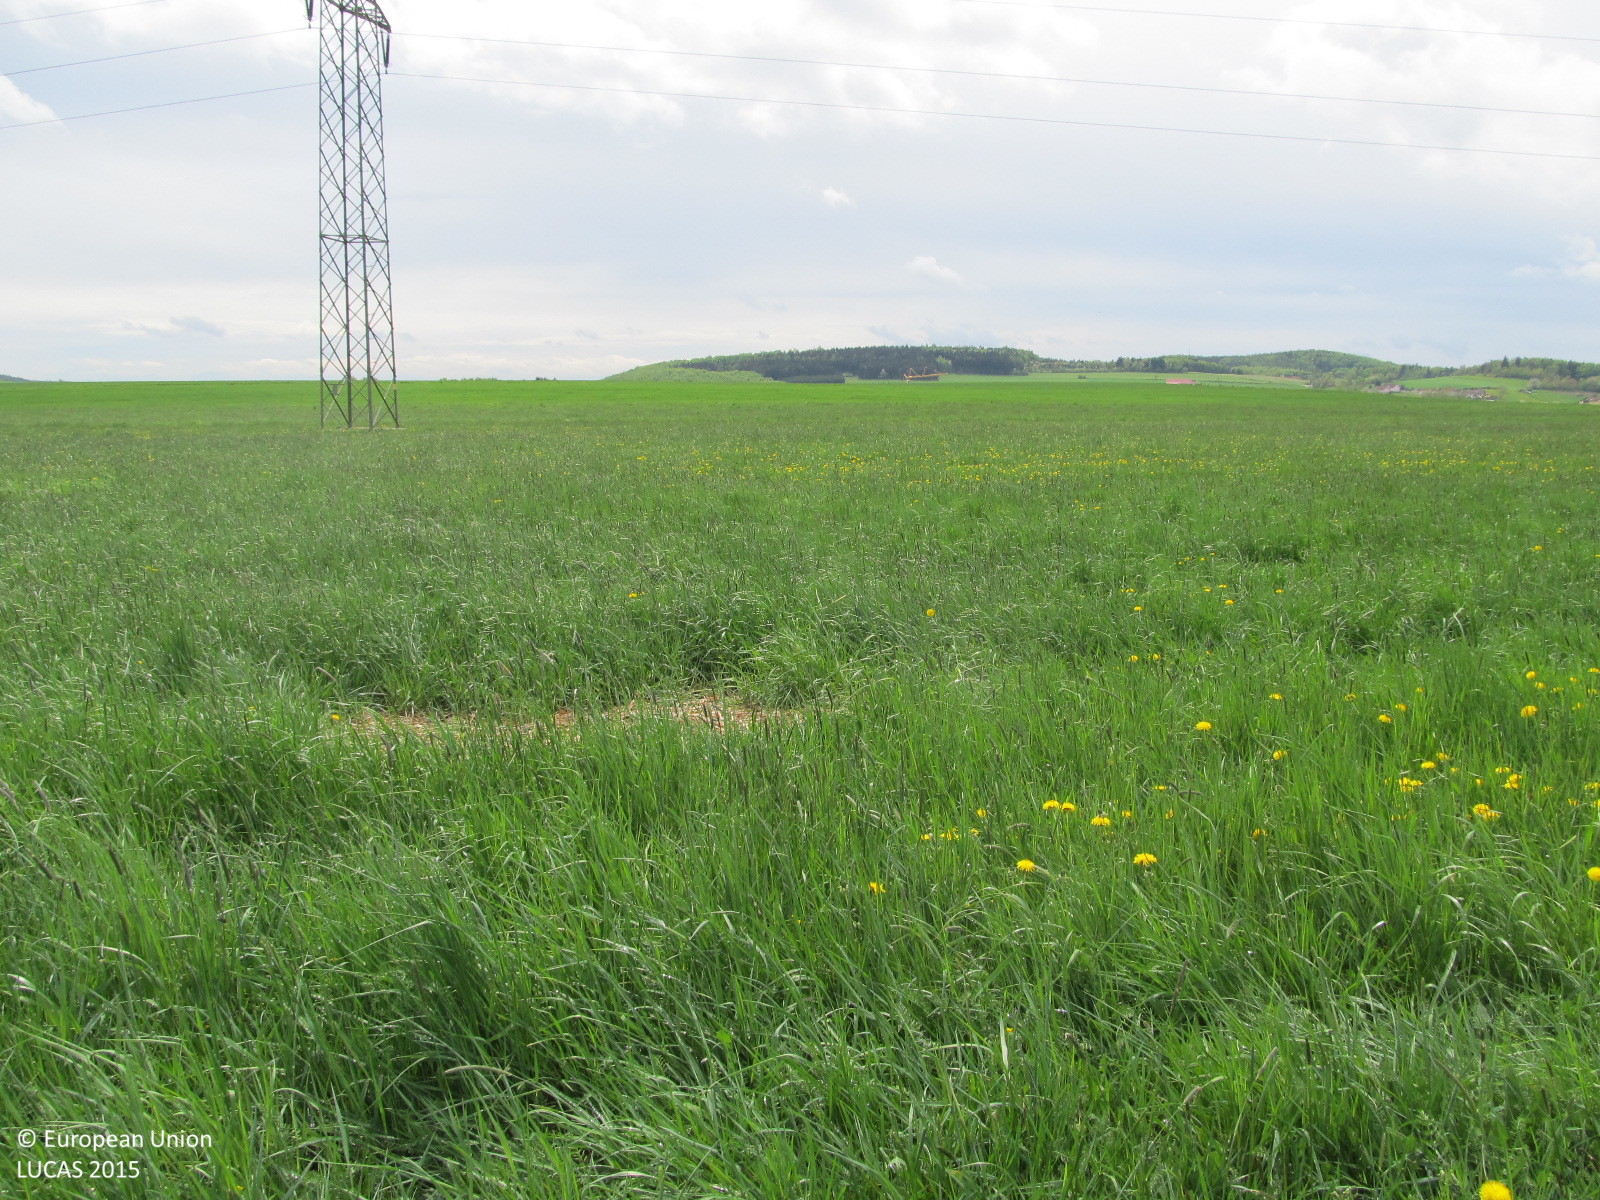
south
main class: Cropland
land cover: Temporary grasslands
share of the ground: > 75 %
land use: Agriculture (excluding fallow land and kitchen gardens)
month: May
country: AT
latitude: 48.5185
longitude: 15.5130
